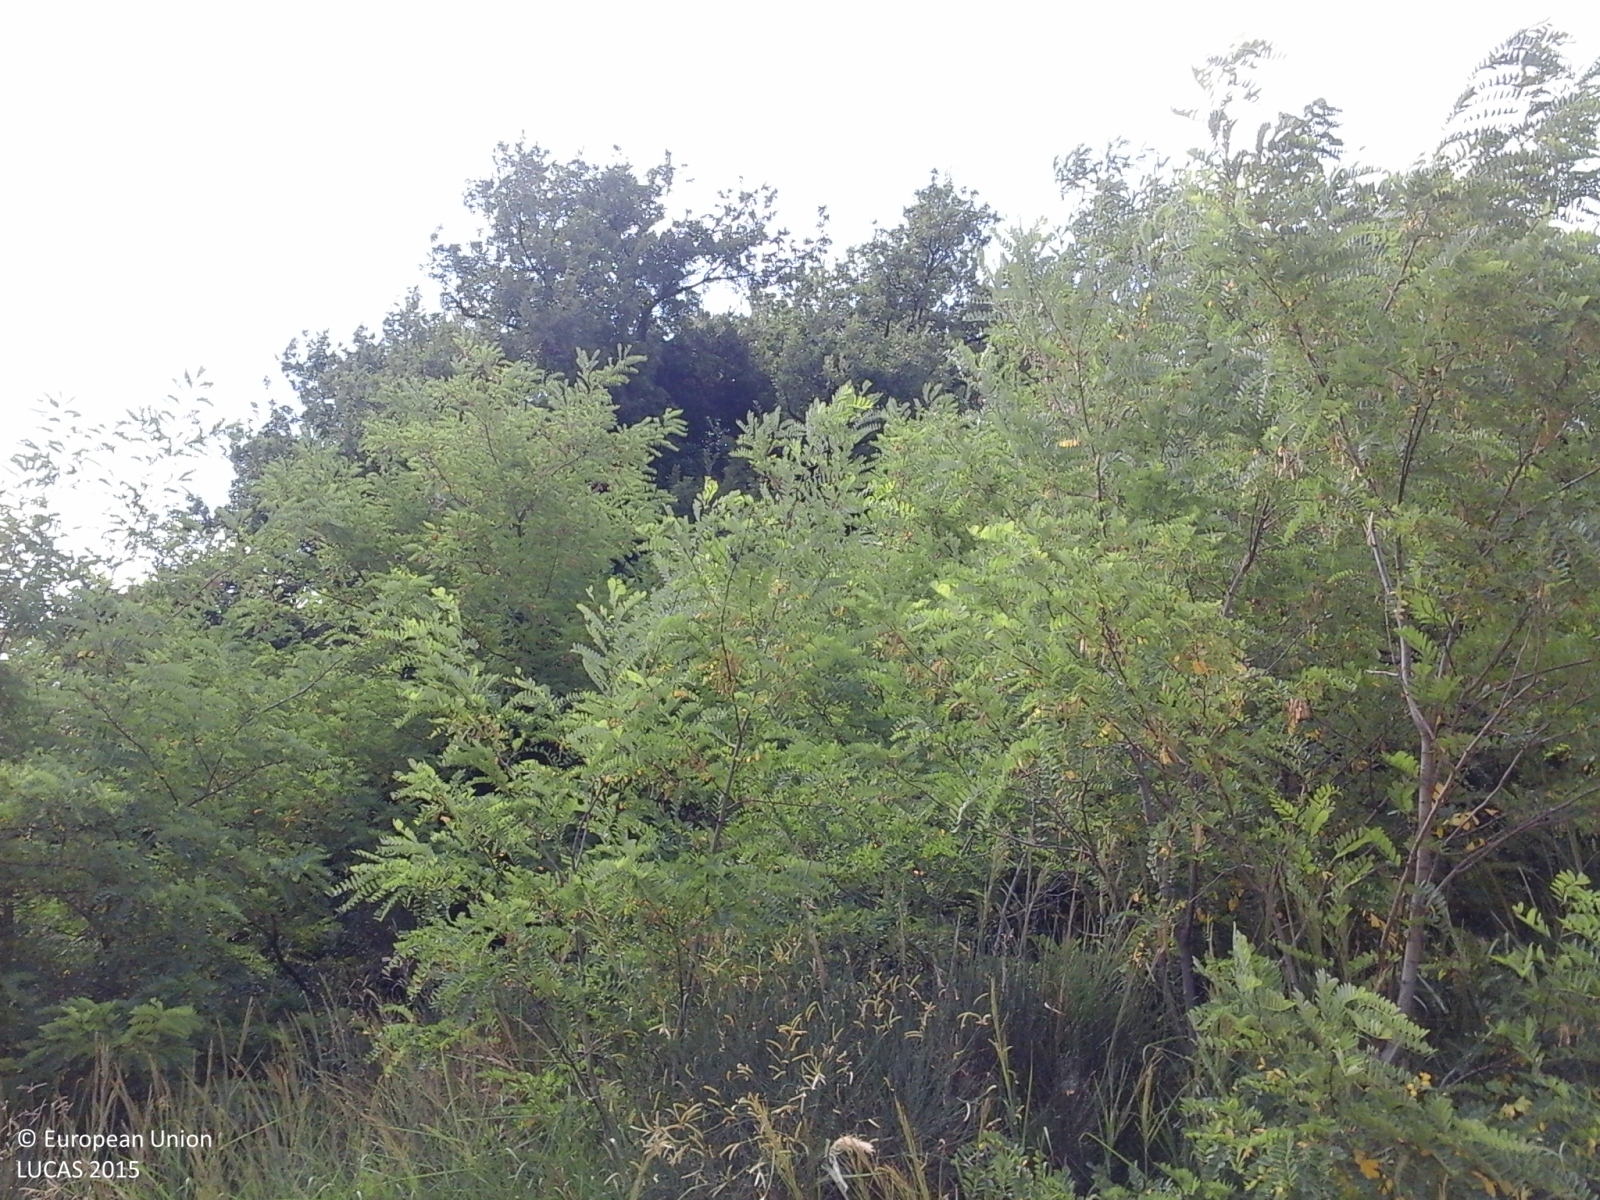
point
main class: Woodland
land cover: Broadleaved woodland
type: thermophilous deciduous forest
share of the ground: > 75 %
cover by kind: broadleaved forest trees 100 %
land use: Semi-natural and natural areas not in use
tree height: > 5 m
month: July
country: IT
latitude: 43.9030
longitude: 12.5960
